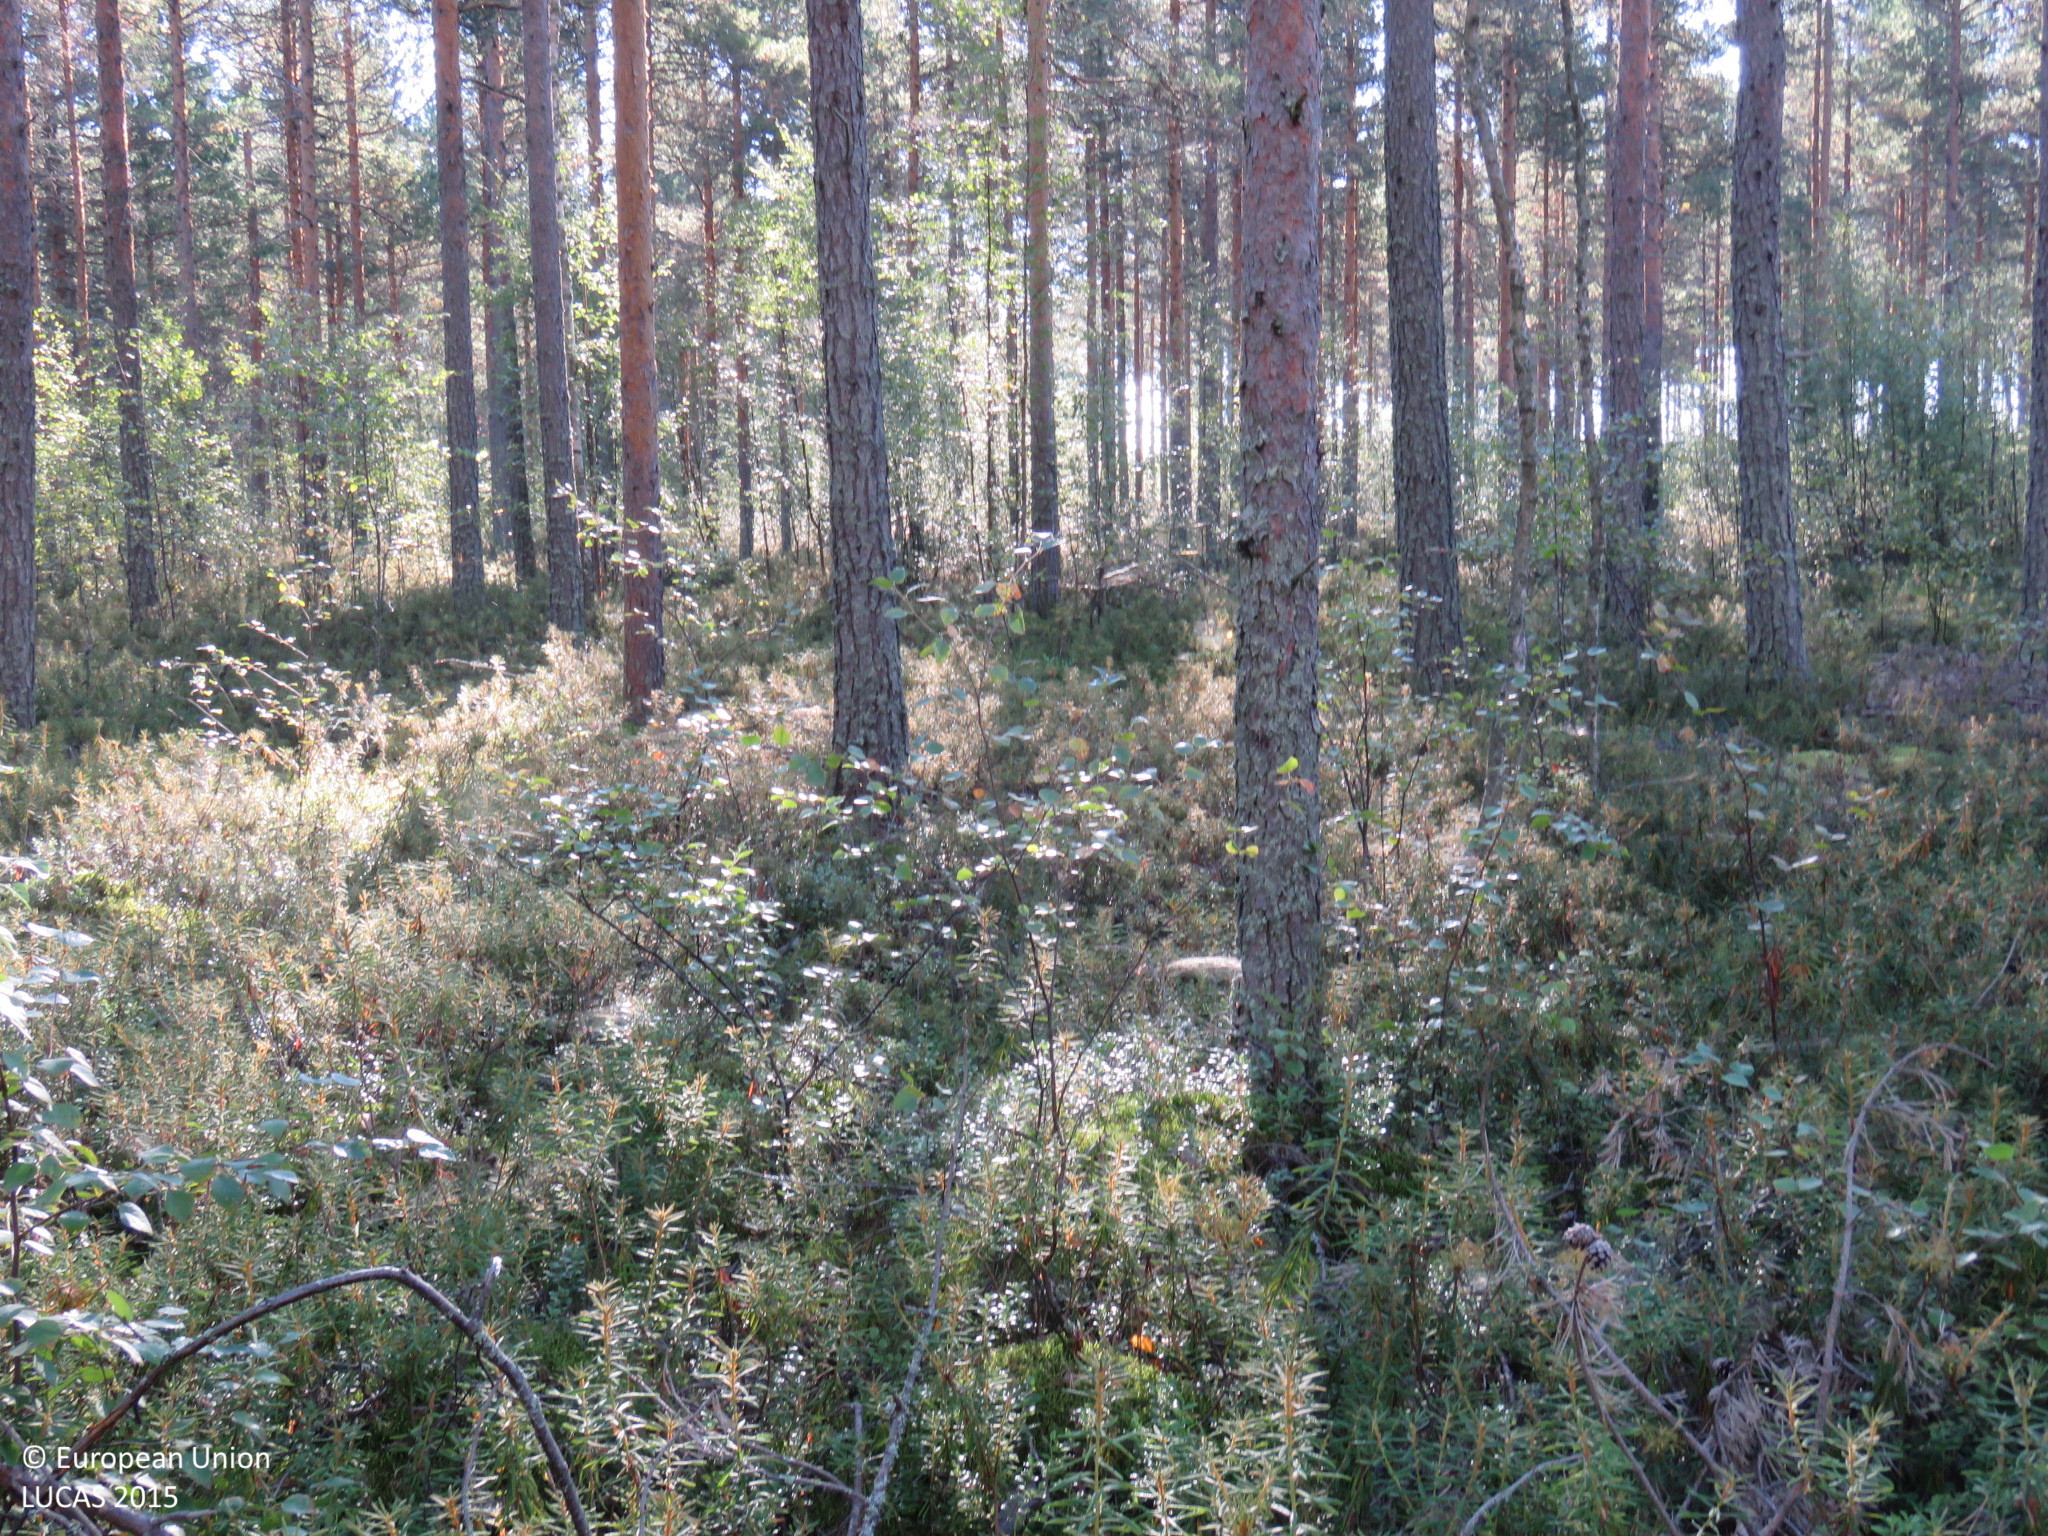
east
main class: Woodland
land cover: Pine dominated coniferous woodland
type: boreal forest
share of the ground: > 75 %
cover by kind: coniferous forest trees 60 %, shrubs 20 %, broadleaved forest trees 15 %, lichens and mosses 5 %
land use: Forestry
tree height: > 5 m
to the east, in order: Pine dominated coniferous woodland; Tracks; Pine dominated coniferous woodland; Pine dominated mixed woodland; Ditches and canals; Pine dominated mixed woodland; Pine dominated coniferous woodland; Tracks; Grass margins; Ditches and canals; Groves; Pine dominated coniferous woodland; Tracks; Pine dominated coniferous woodland; Ditches and canals; Grass margins; Barley
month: August
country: FI
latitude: 64.9842
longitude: 24.6695
